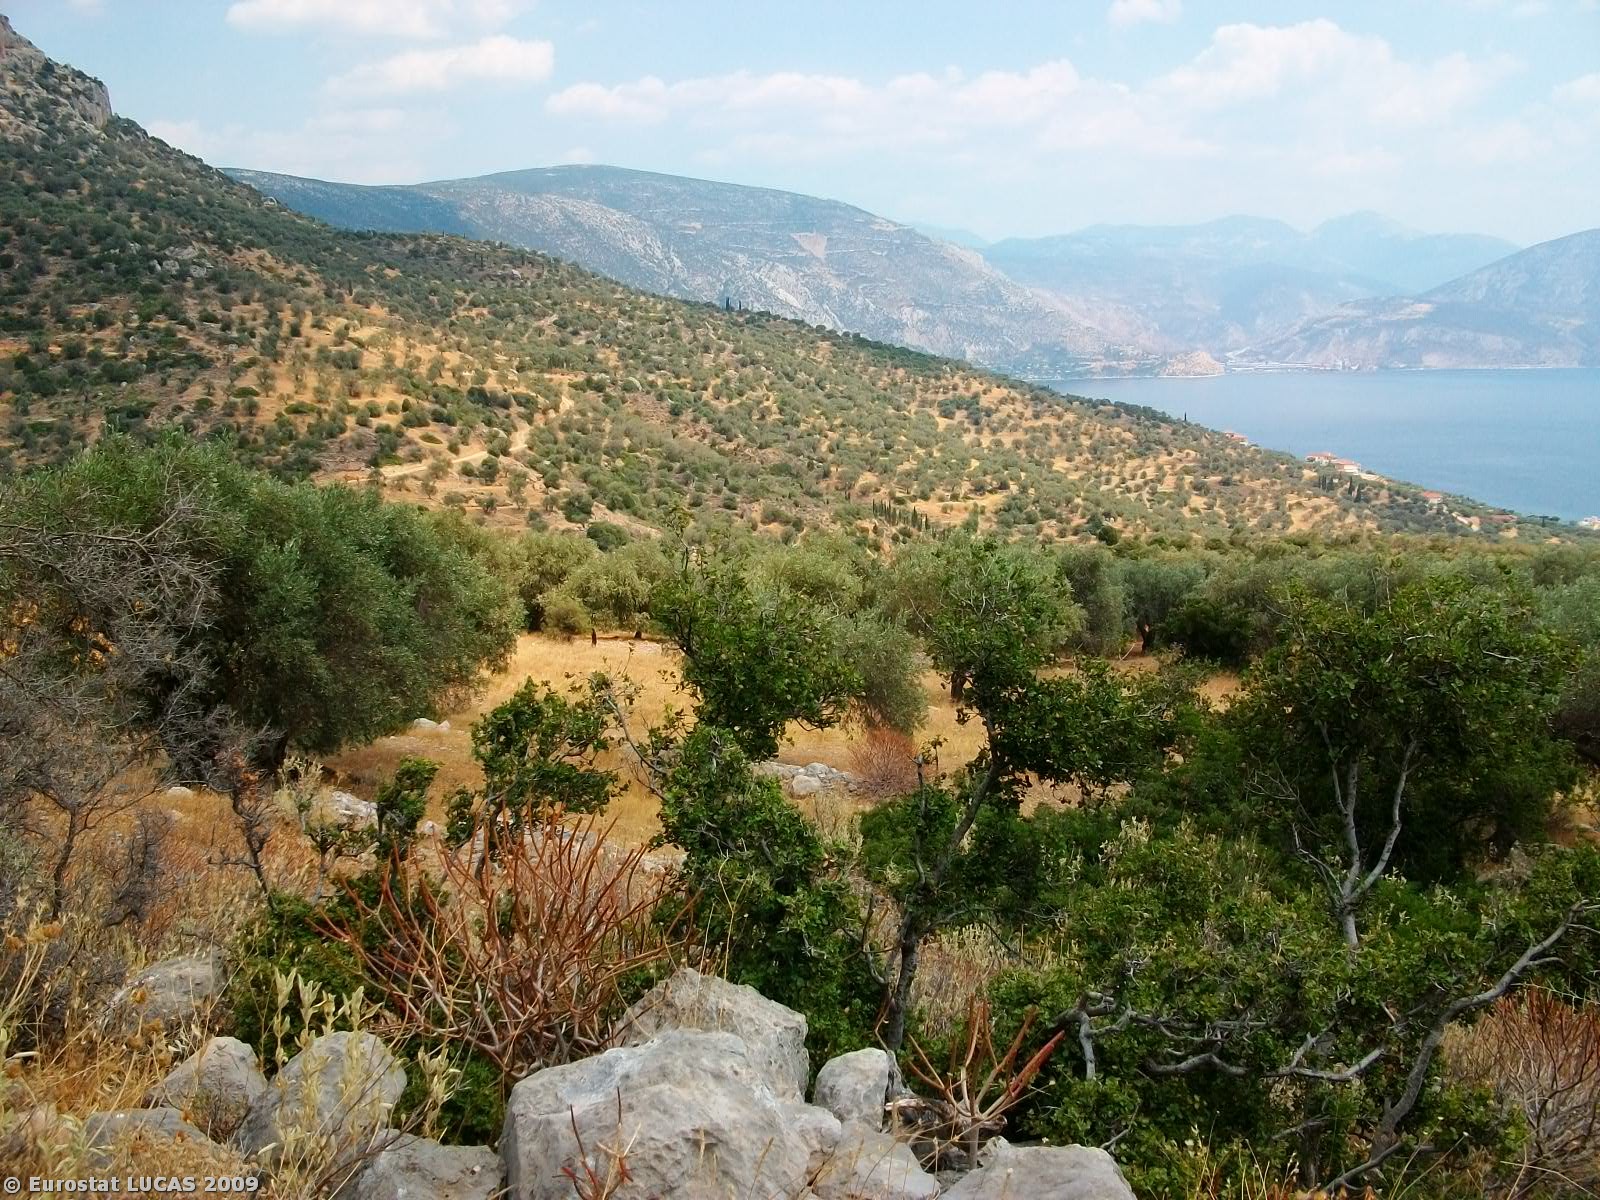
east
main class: Cropland
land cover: Olive groves
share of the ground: 10 - 25 %
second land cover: Grassland with sparse tree/shrub cover
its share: 50 - 75 %
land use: Agriculture (excluding fallow land and kitchen gardens)
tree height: < 5 m
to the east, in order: Olive groves; Grassland with sparse tree/shrub cover; Dry stone walls; Olive groves; Grassland with sparse tree/shrub cover; Dry stone walls; Olive groves; Grassland with sparse tree/shrub cover; Dry stone walls; Olive groves; Grassland with sparse tree/shrub cover; Dry stone walls; Olive groves; Grassland with sparse tree/shrub cover; Dry stone walls; Olive groves; Grassland with sparse tree/shrub cover; Grass margins; Tracks; Grass margins; Olive groves; Grassland with sparse tree/shrub cover; Abandoned hedges; Olive groves; Grassland with sparse tree/shrub cover; Shrubland with sparse tree cover
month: July
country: GR
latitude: 38.3865
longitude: 22.6261
